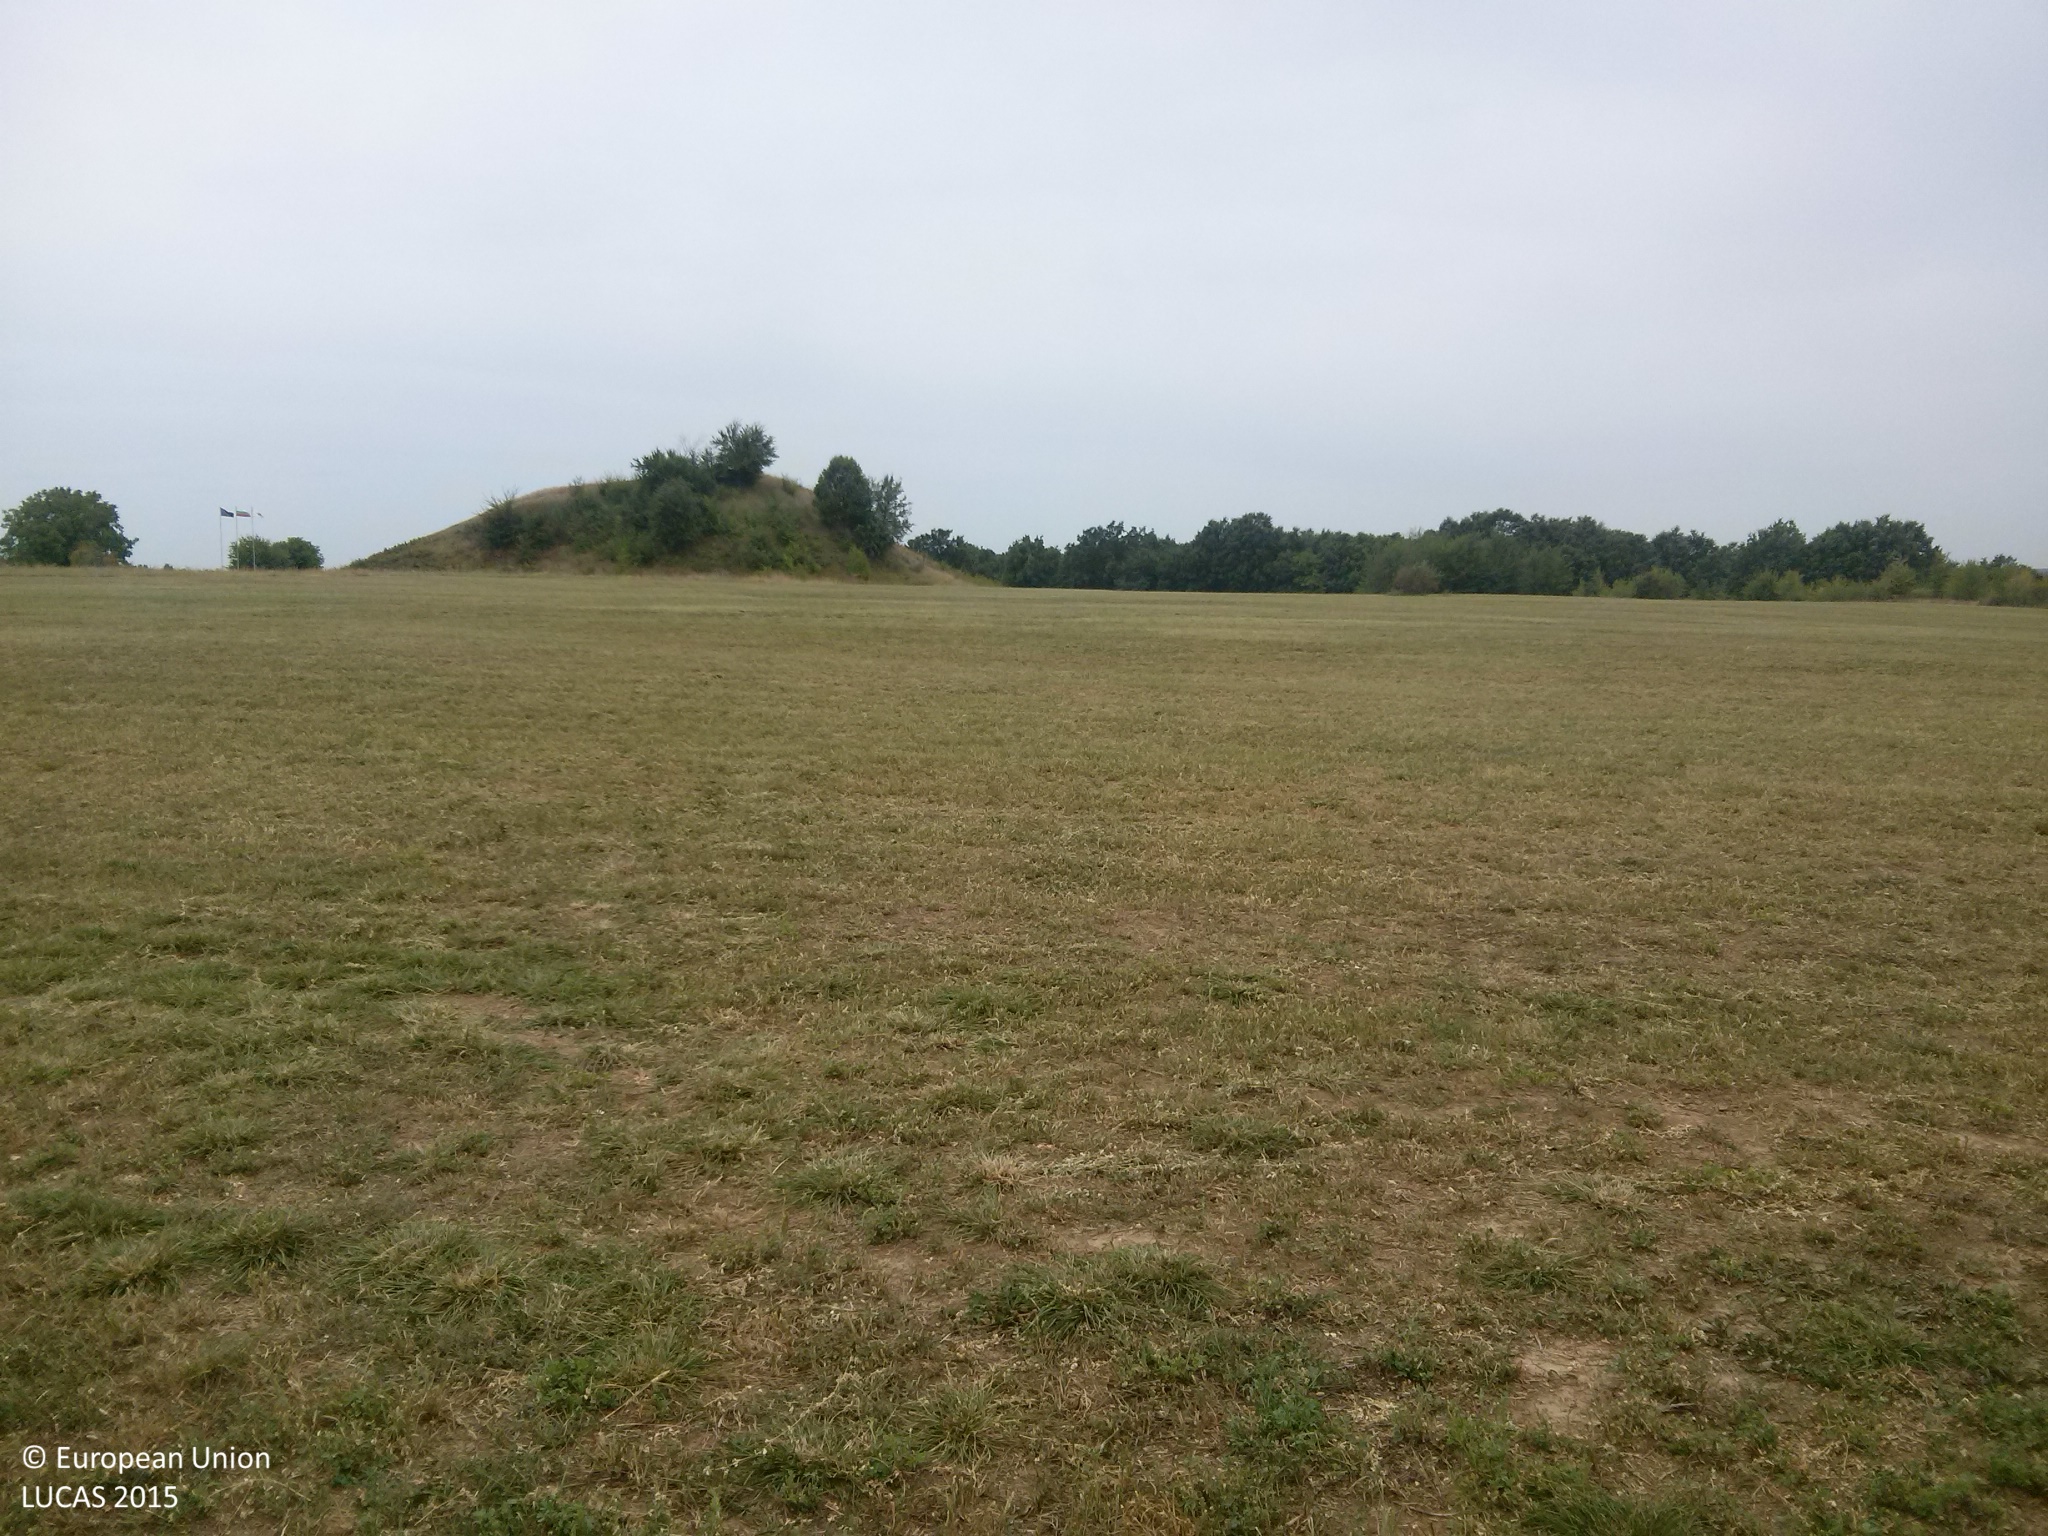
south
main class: Cropland
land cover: Lucerne
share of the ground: 50 - 75 %
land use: Agriculture (excluding fallow land and kitchen gardens)
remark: Harvested field
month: September
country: BG
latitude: 43.7469
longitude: 26.7670
